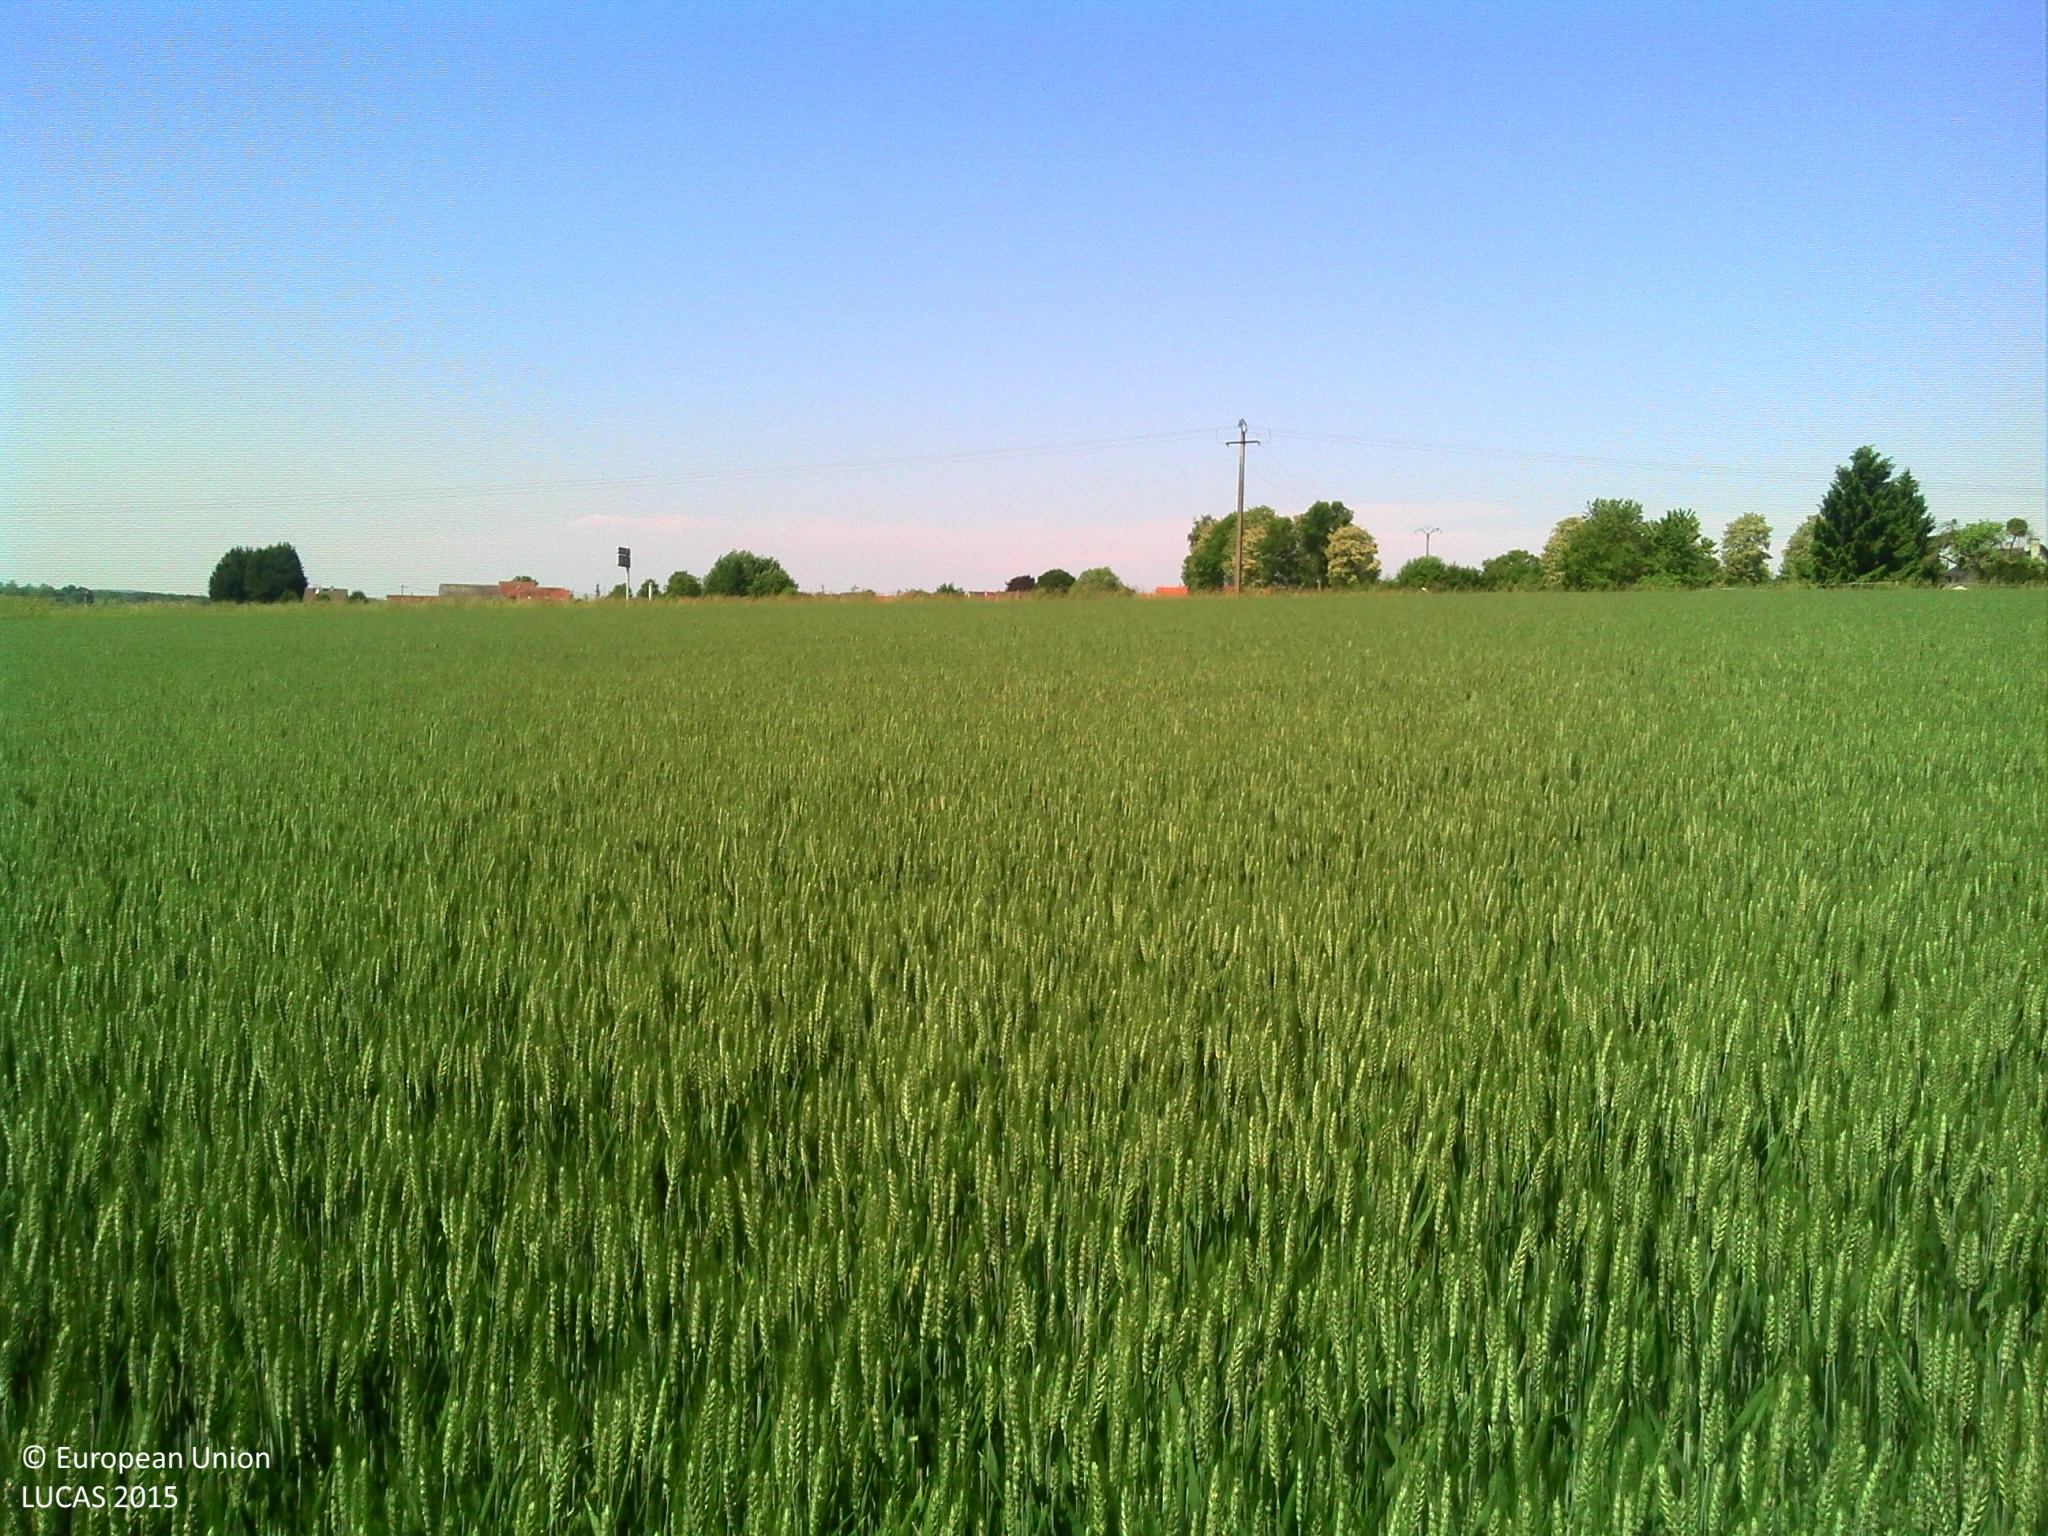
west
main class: Cropland
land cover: Common wheat
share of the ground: > 75 %
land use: Agriculture (excluding fallow land and kitchen gardens)
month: June
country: FR
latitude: 49.5695
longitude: 3.2577
